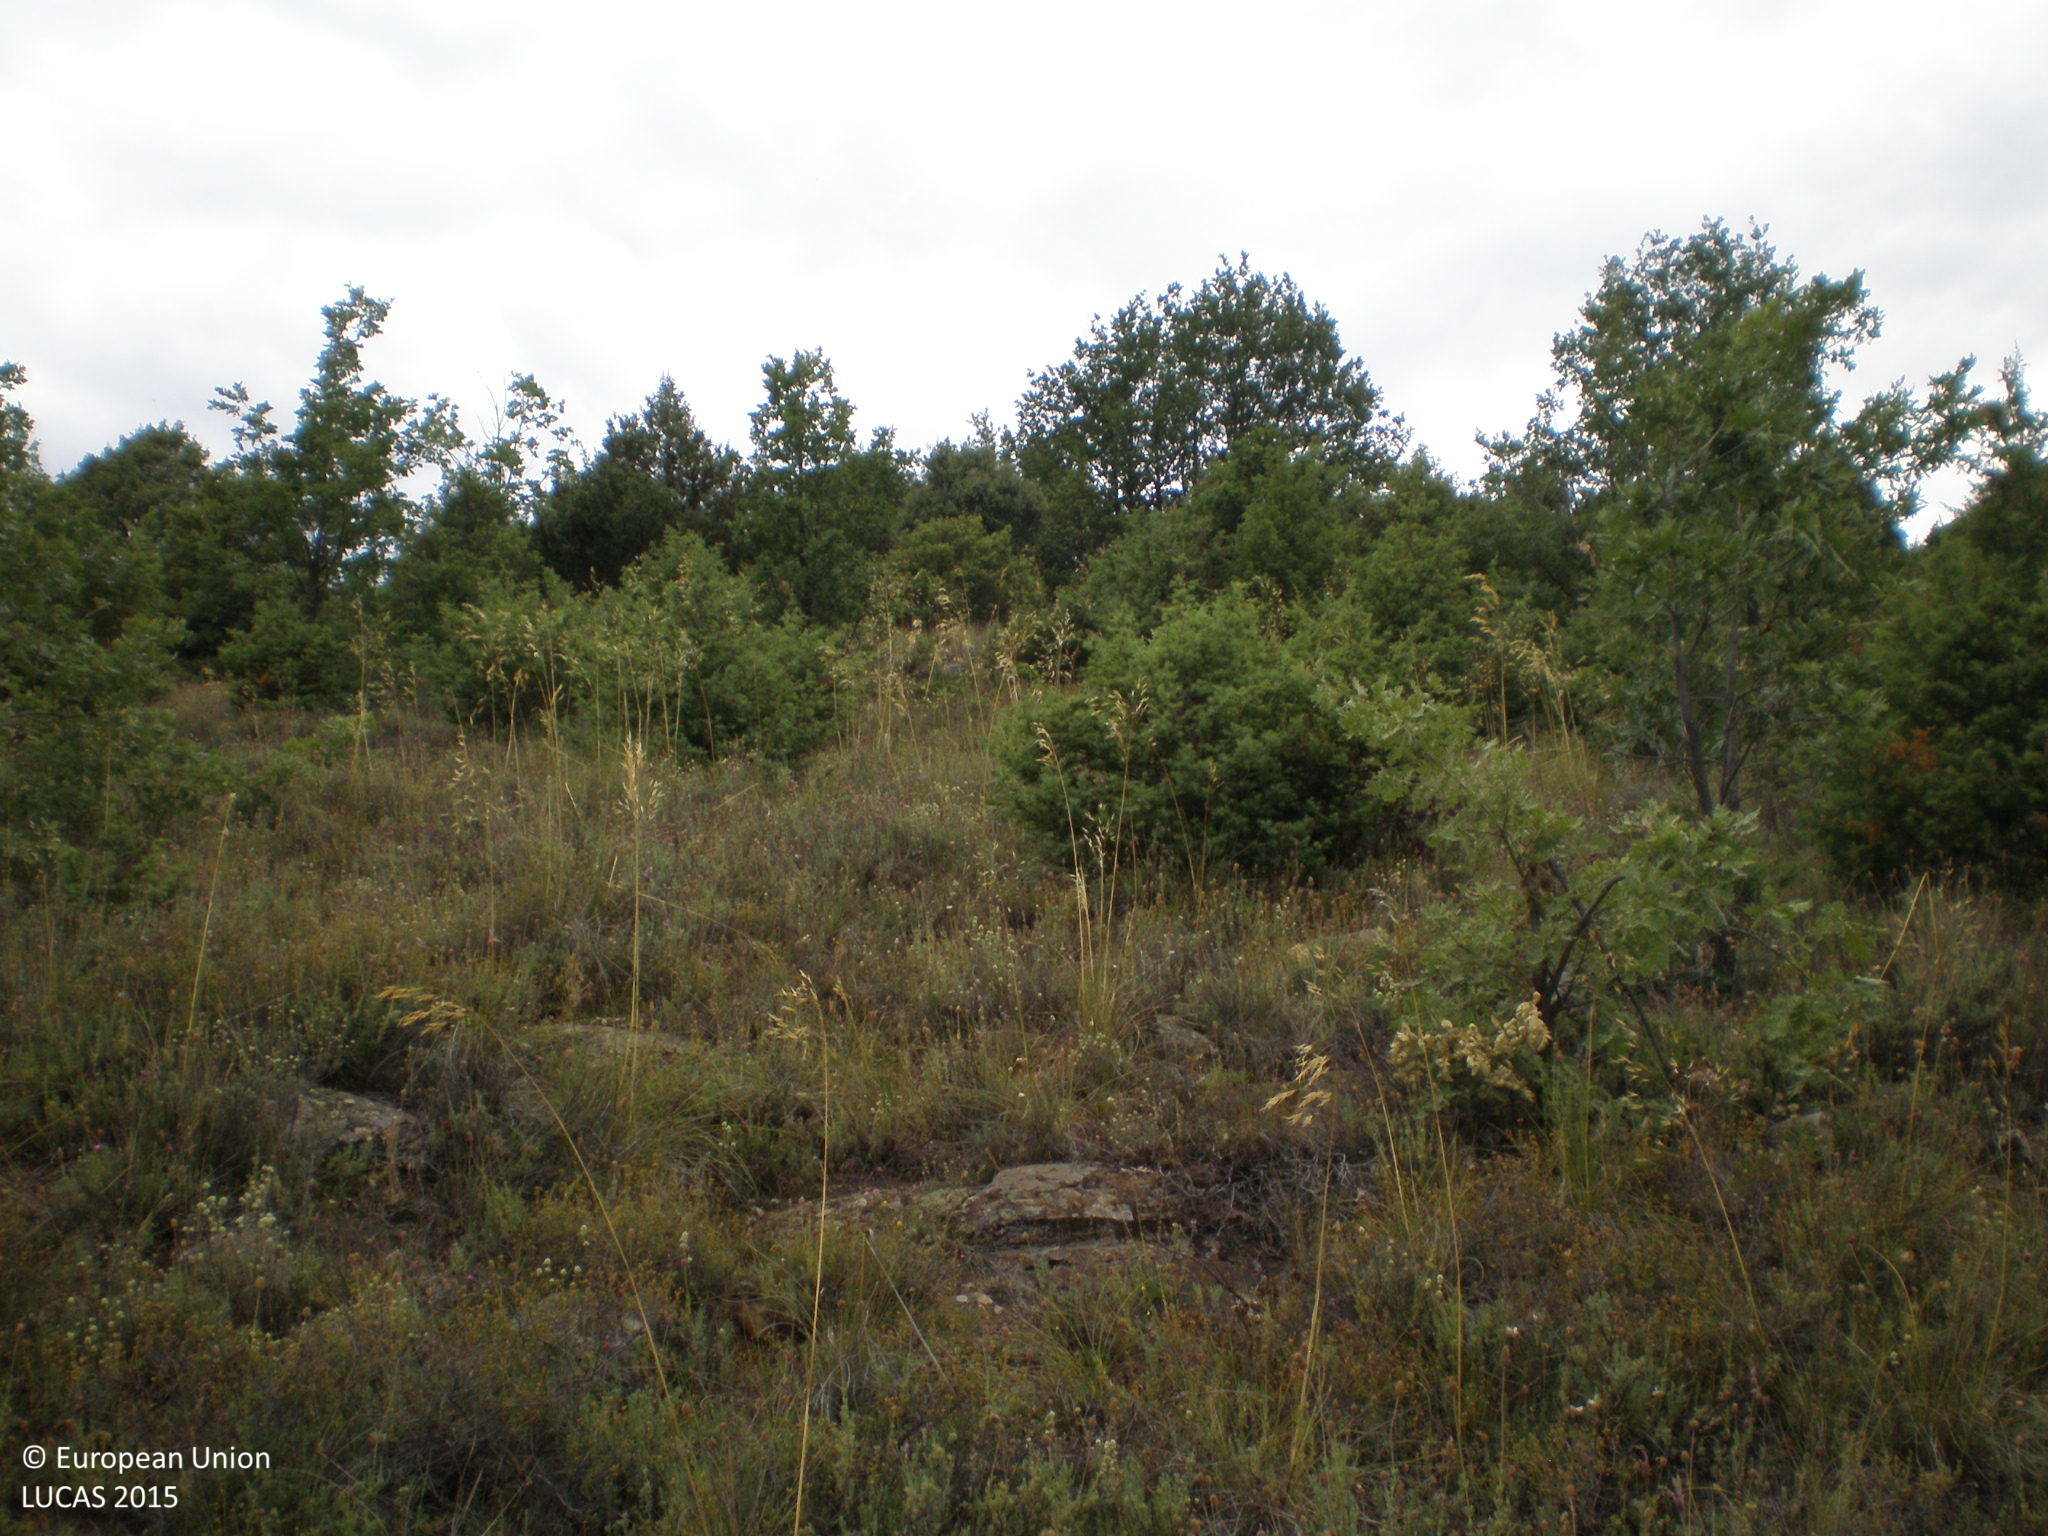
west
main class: Shrubland
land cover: Shrubland without tree cover
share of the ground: > 75 %
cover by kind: shrubs 100 %
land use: Semi-natural and natural areas not in use
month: June
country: ES
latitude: 40.3114
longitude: -5.5147
